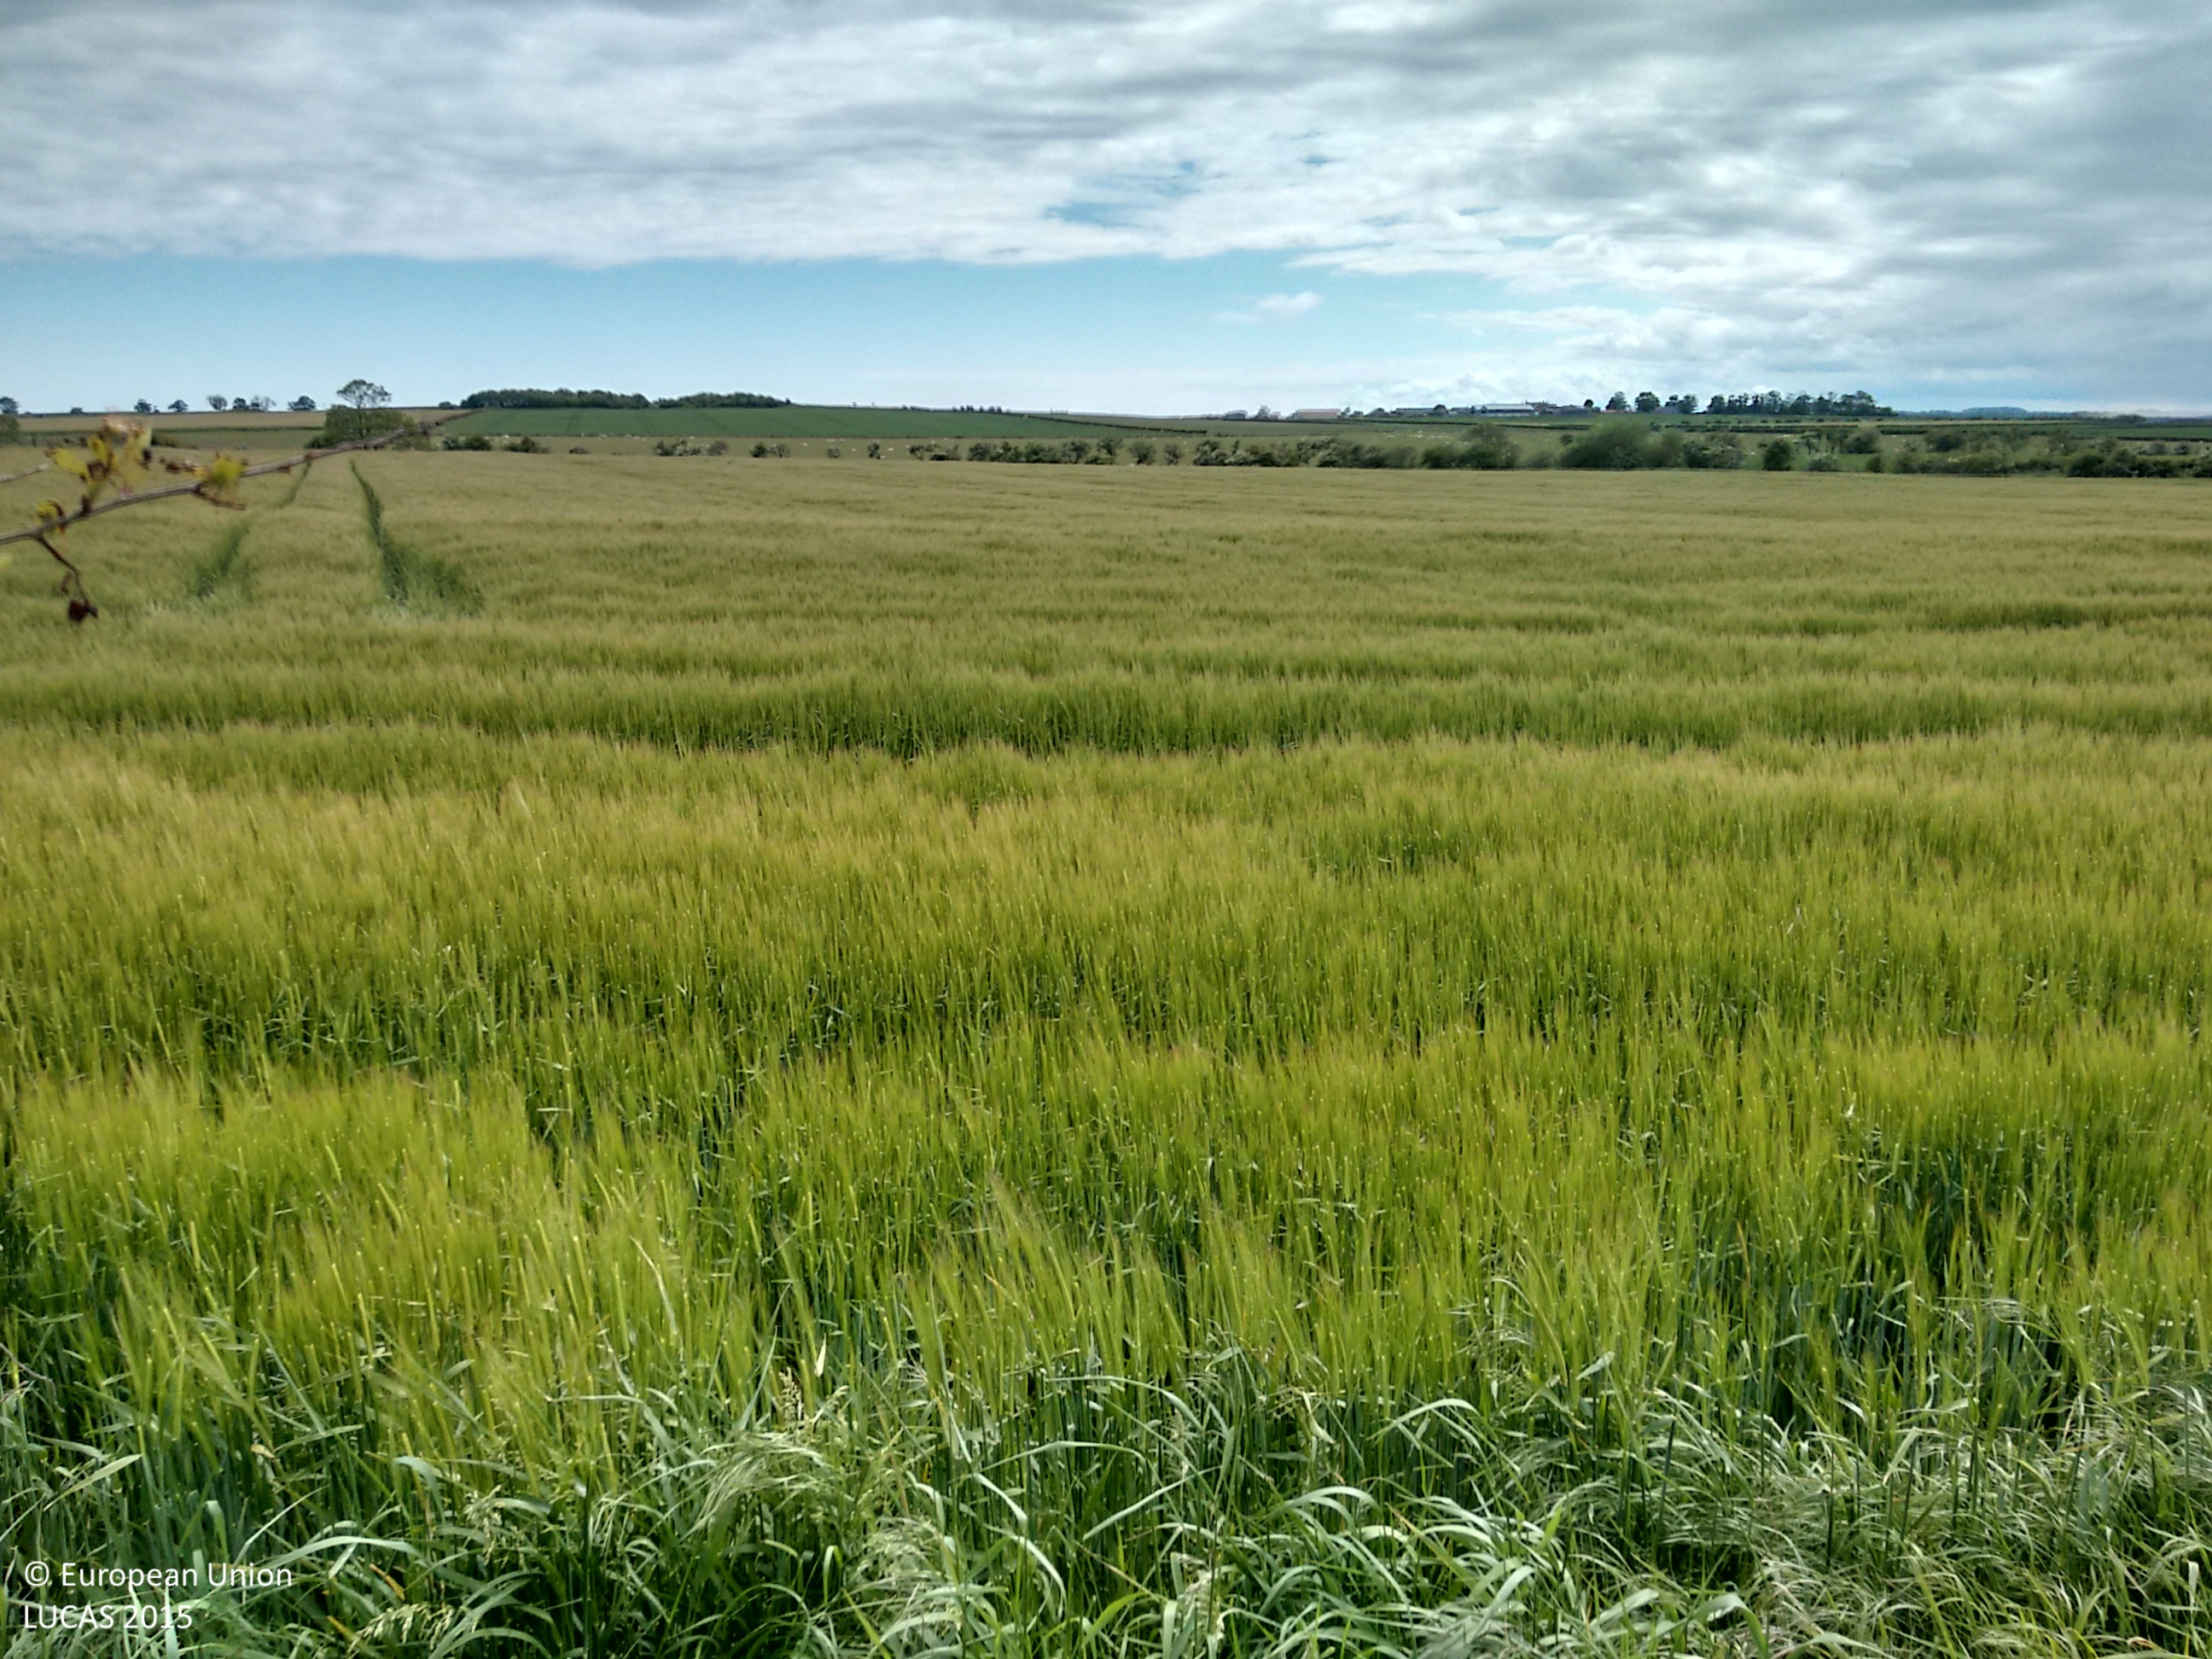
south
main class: Cropland
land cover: Temporary grasslands
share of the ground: > 75 %
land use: Agriculture (excluding fallow land and kitchen gardens)
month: June
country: GB
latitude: 55.5622
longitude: -1.6703
